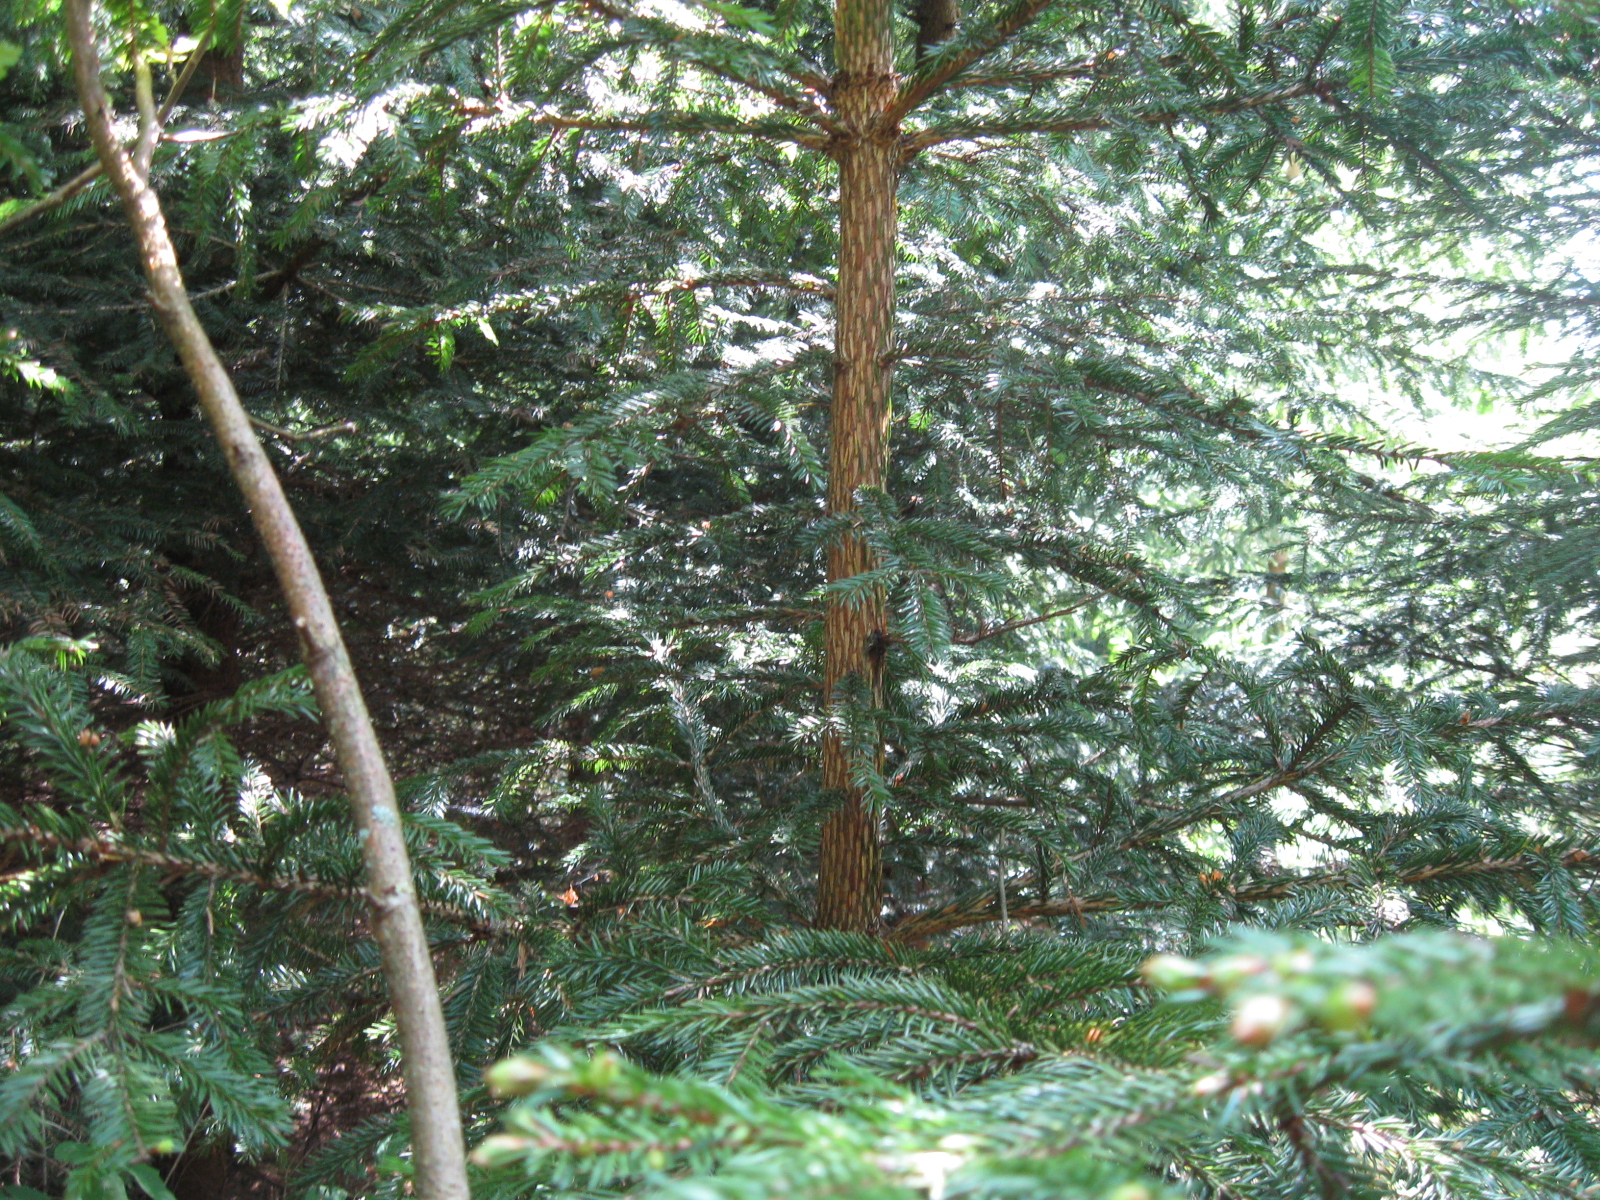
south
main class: Woodland
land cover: Spruce dominated mixed woodland
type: hemiboreal forest and nemoral coniferous forest and mixed broadleaved-coniferous forest
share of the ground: > 75 %
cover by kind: coniferous forest trees 75 %, broadleaved forest trees 25 %
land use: Forestry
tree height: > 5 m
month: May
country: LT
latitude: 54.2690
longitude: 23.2990
